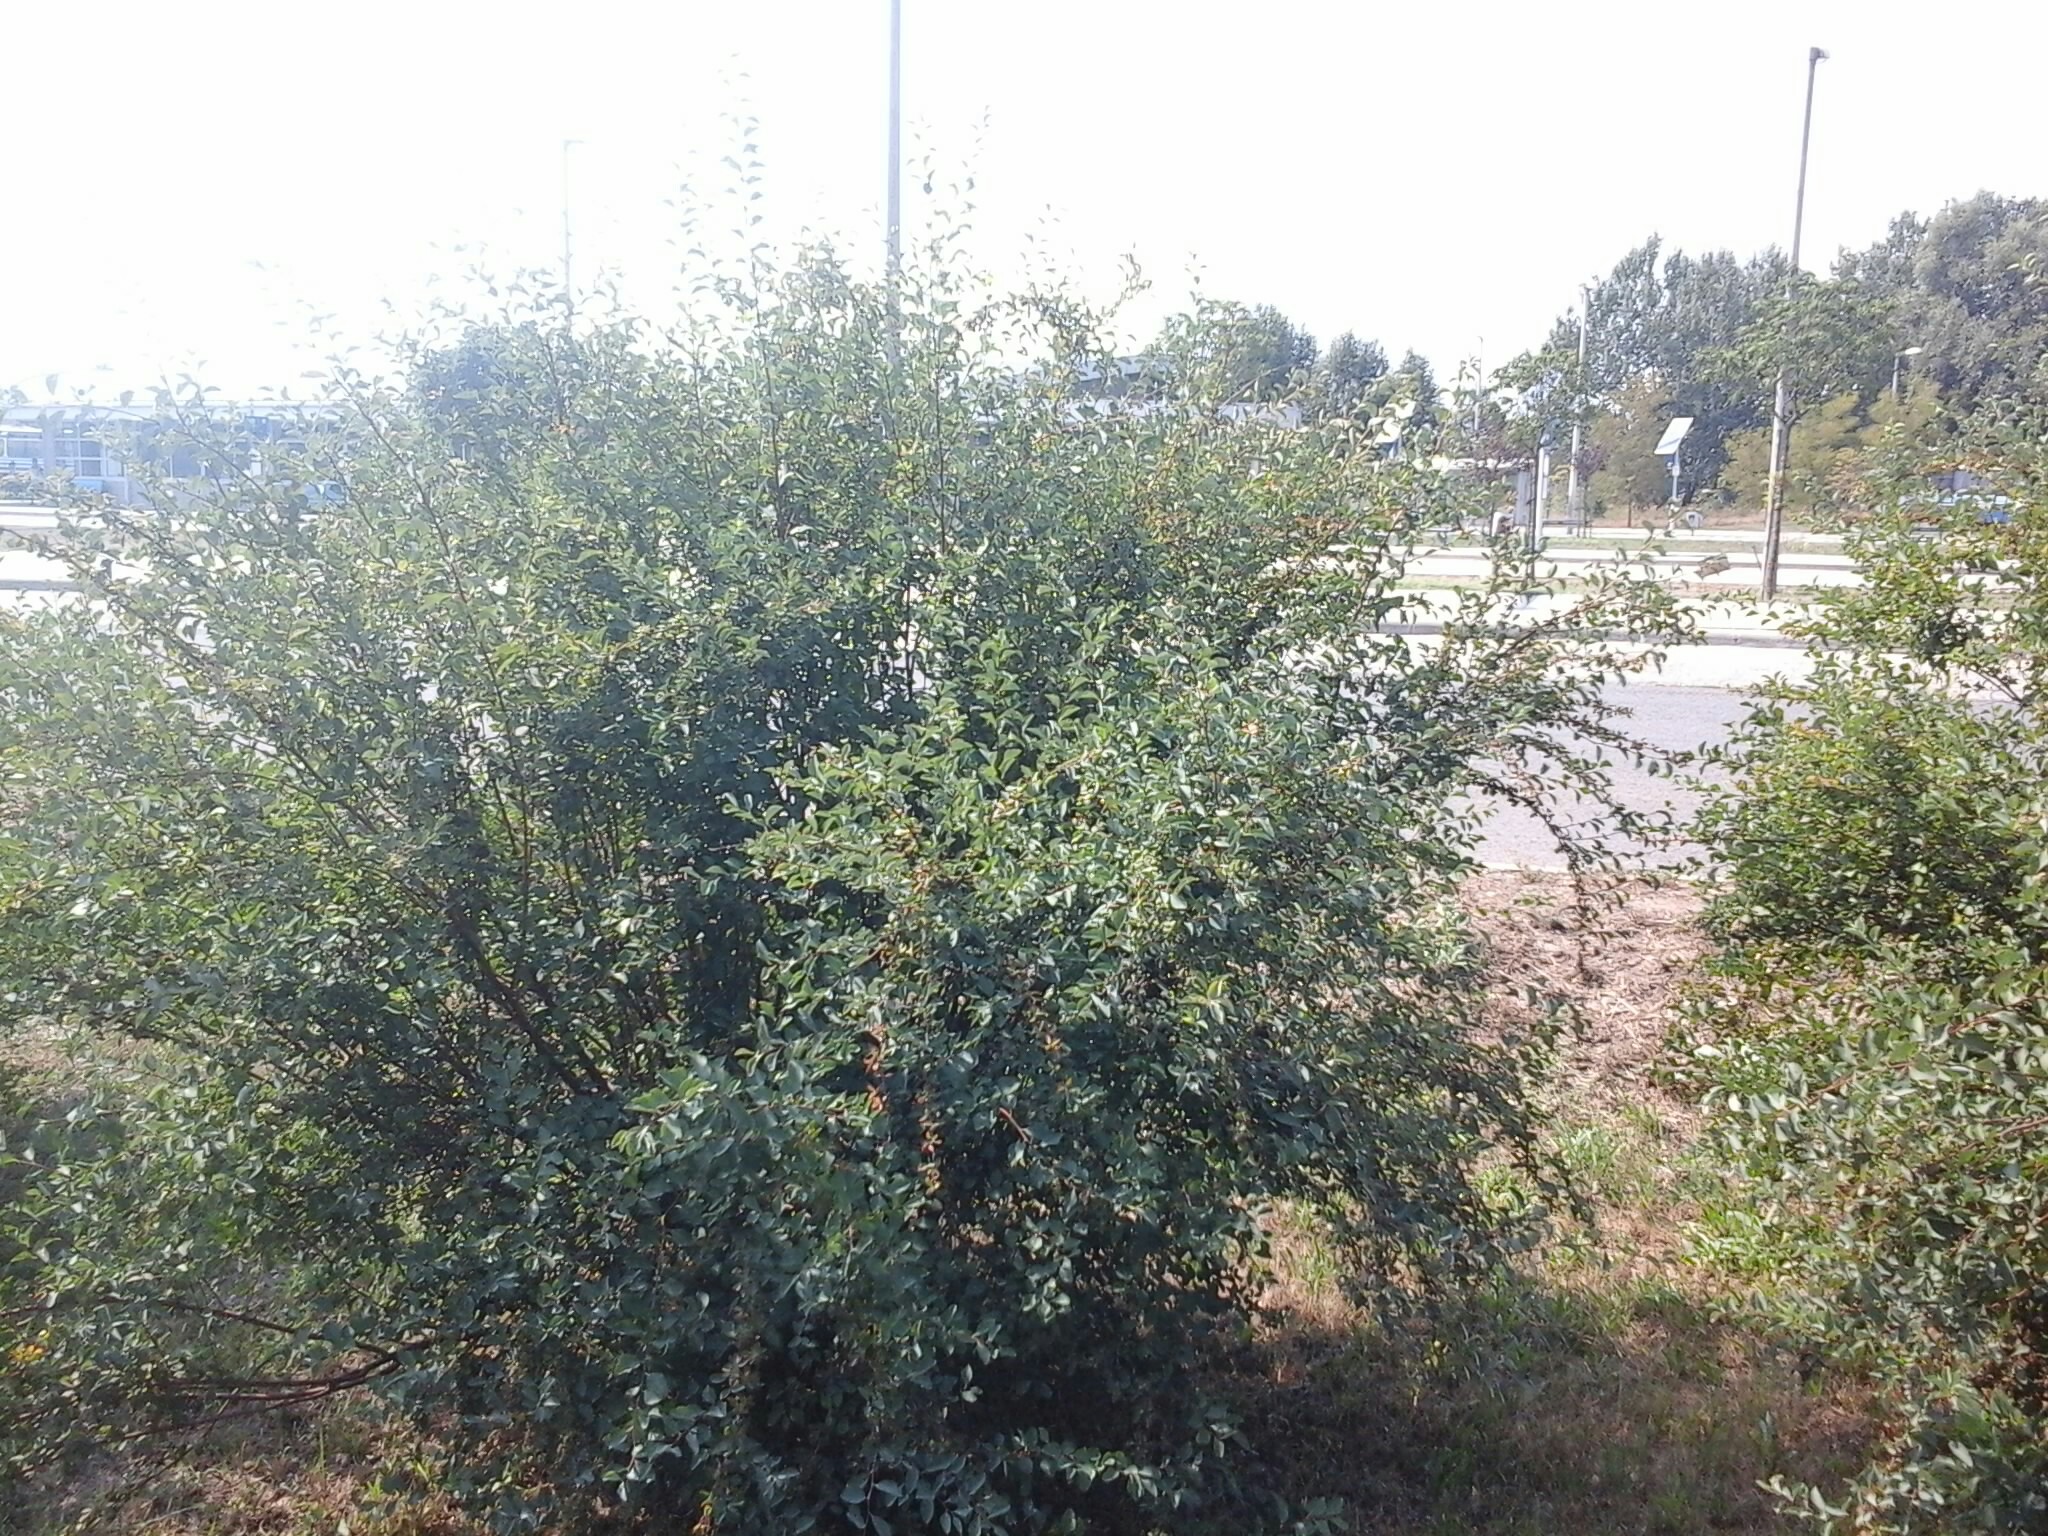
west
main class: Cropland
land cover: Vineyards
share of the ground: 10 - 25 %
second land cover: Grassland without tree/shrub cover
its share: 50 - 75 %
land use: Kitchen garden
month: August
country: HU
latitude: 48.0834
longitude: 19.2980
